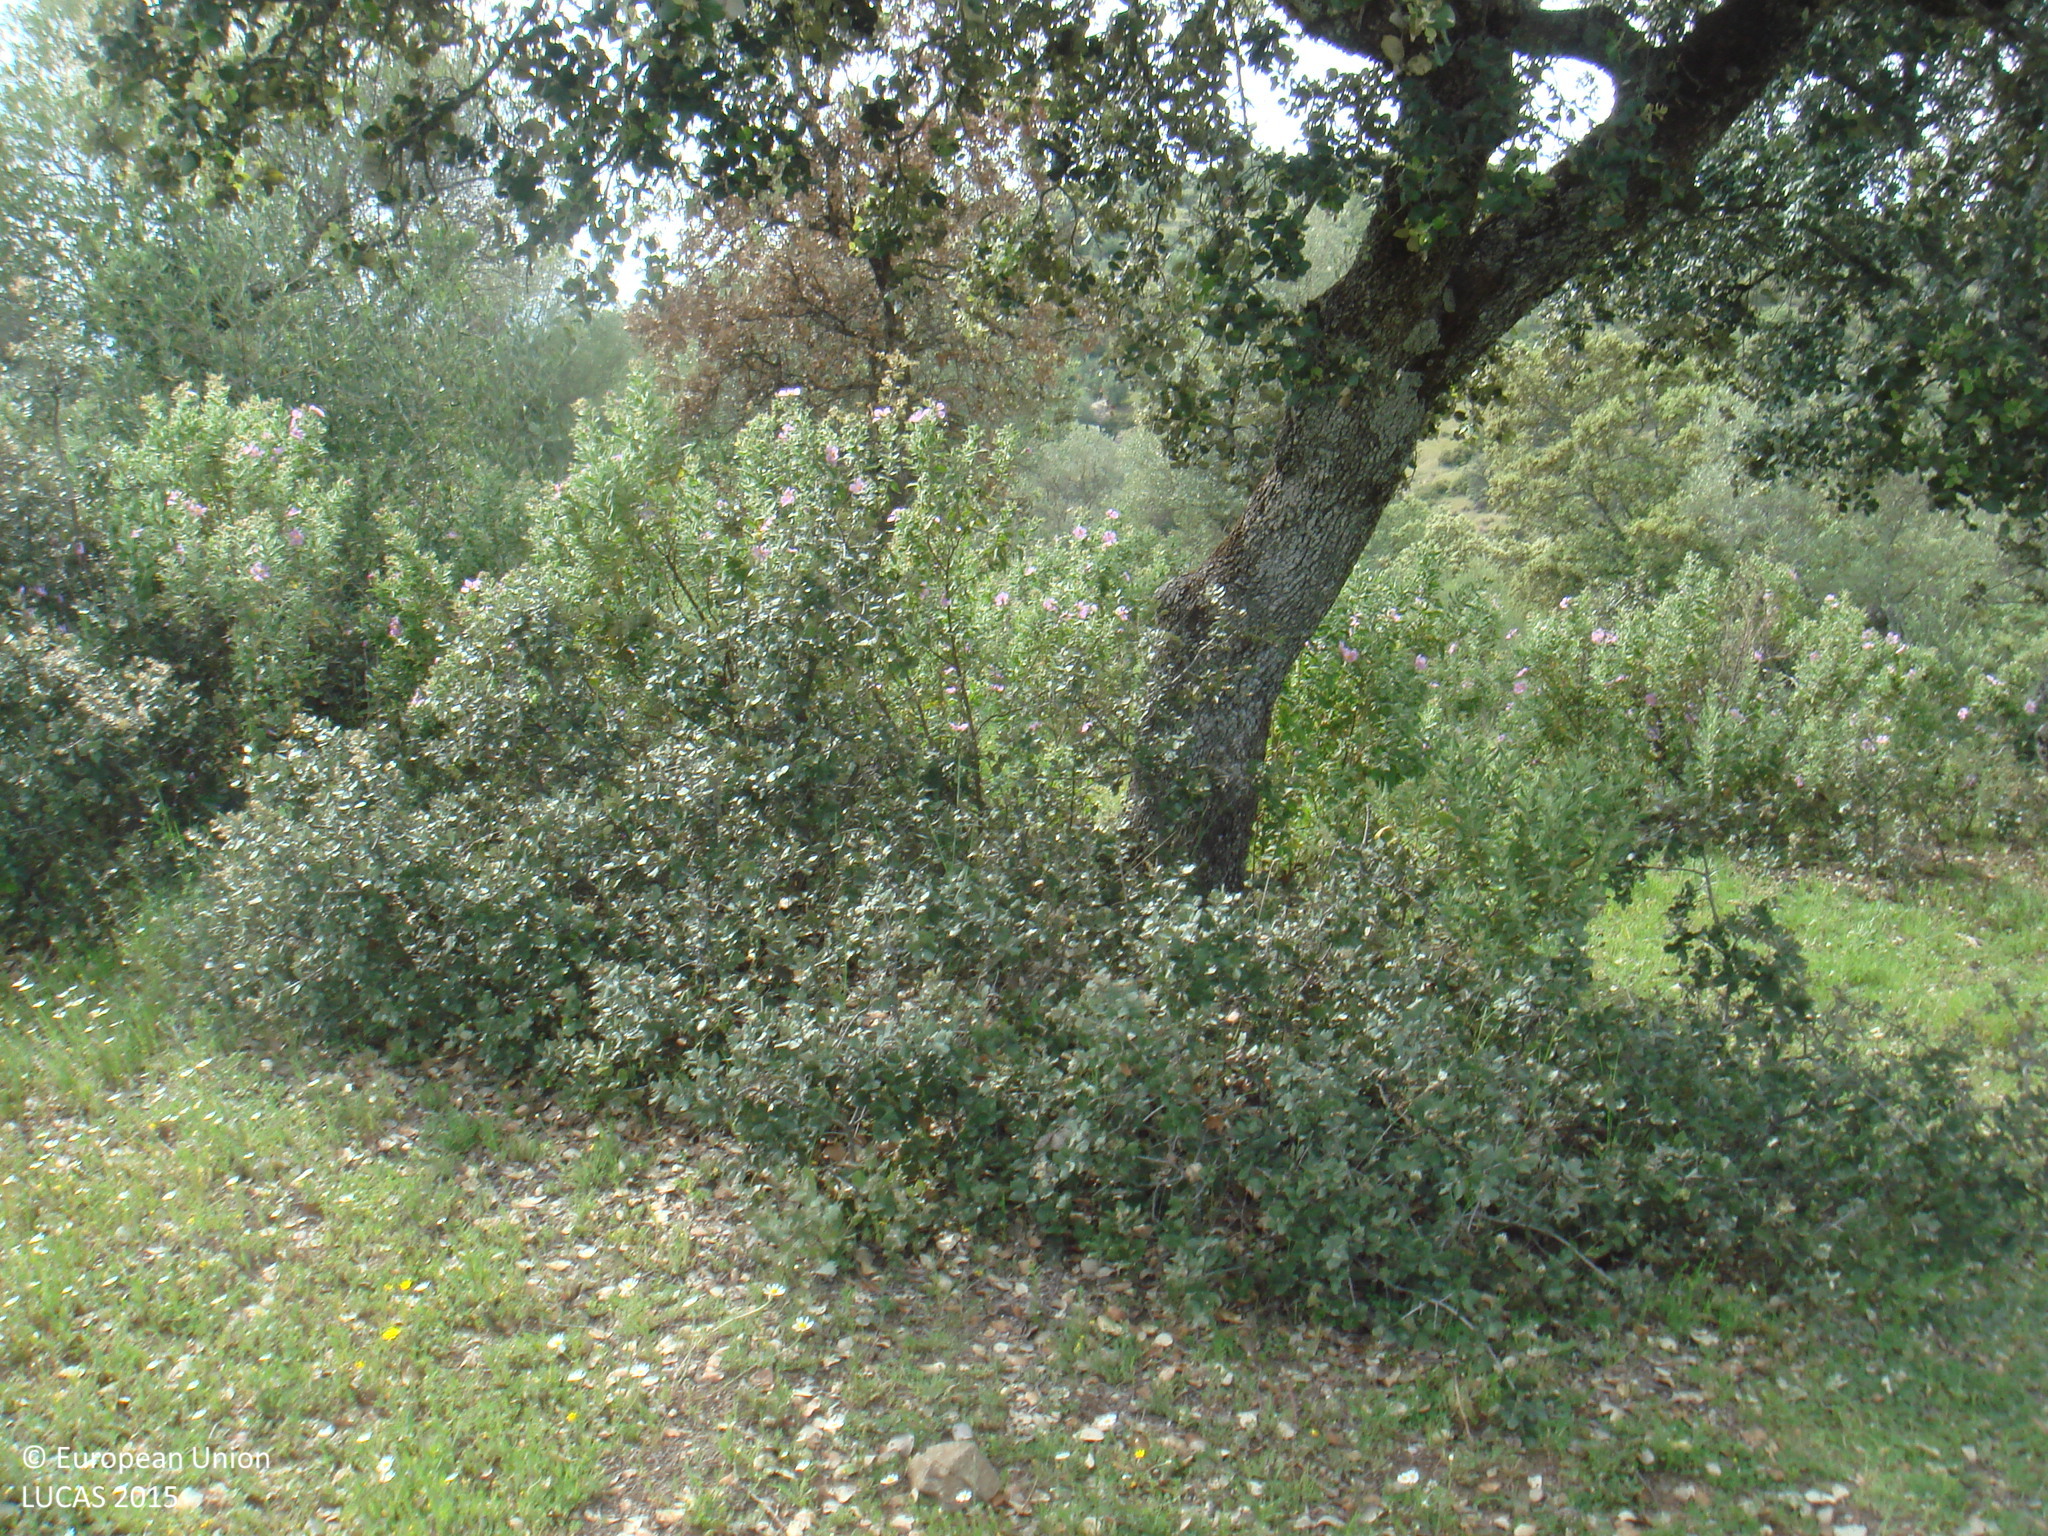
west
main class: Cropland
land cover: Olive groves
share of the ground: 10 - 25 %
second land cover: Grassland without tree/shrub cover
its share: > 75 %
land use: Agriculture (excluding fallow land and kitchen gardens)
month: April
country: ES
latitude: 38.2036
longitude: -5.0170
